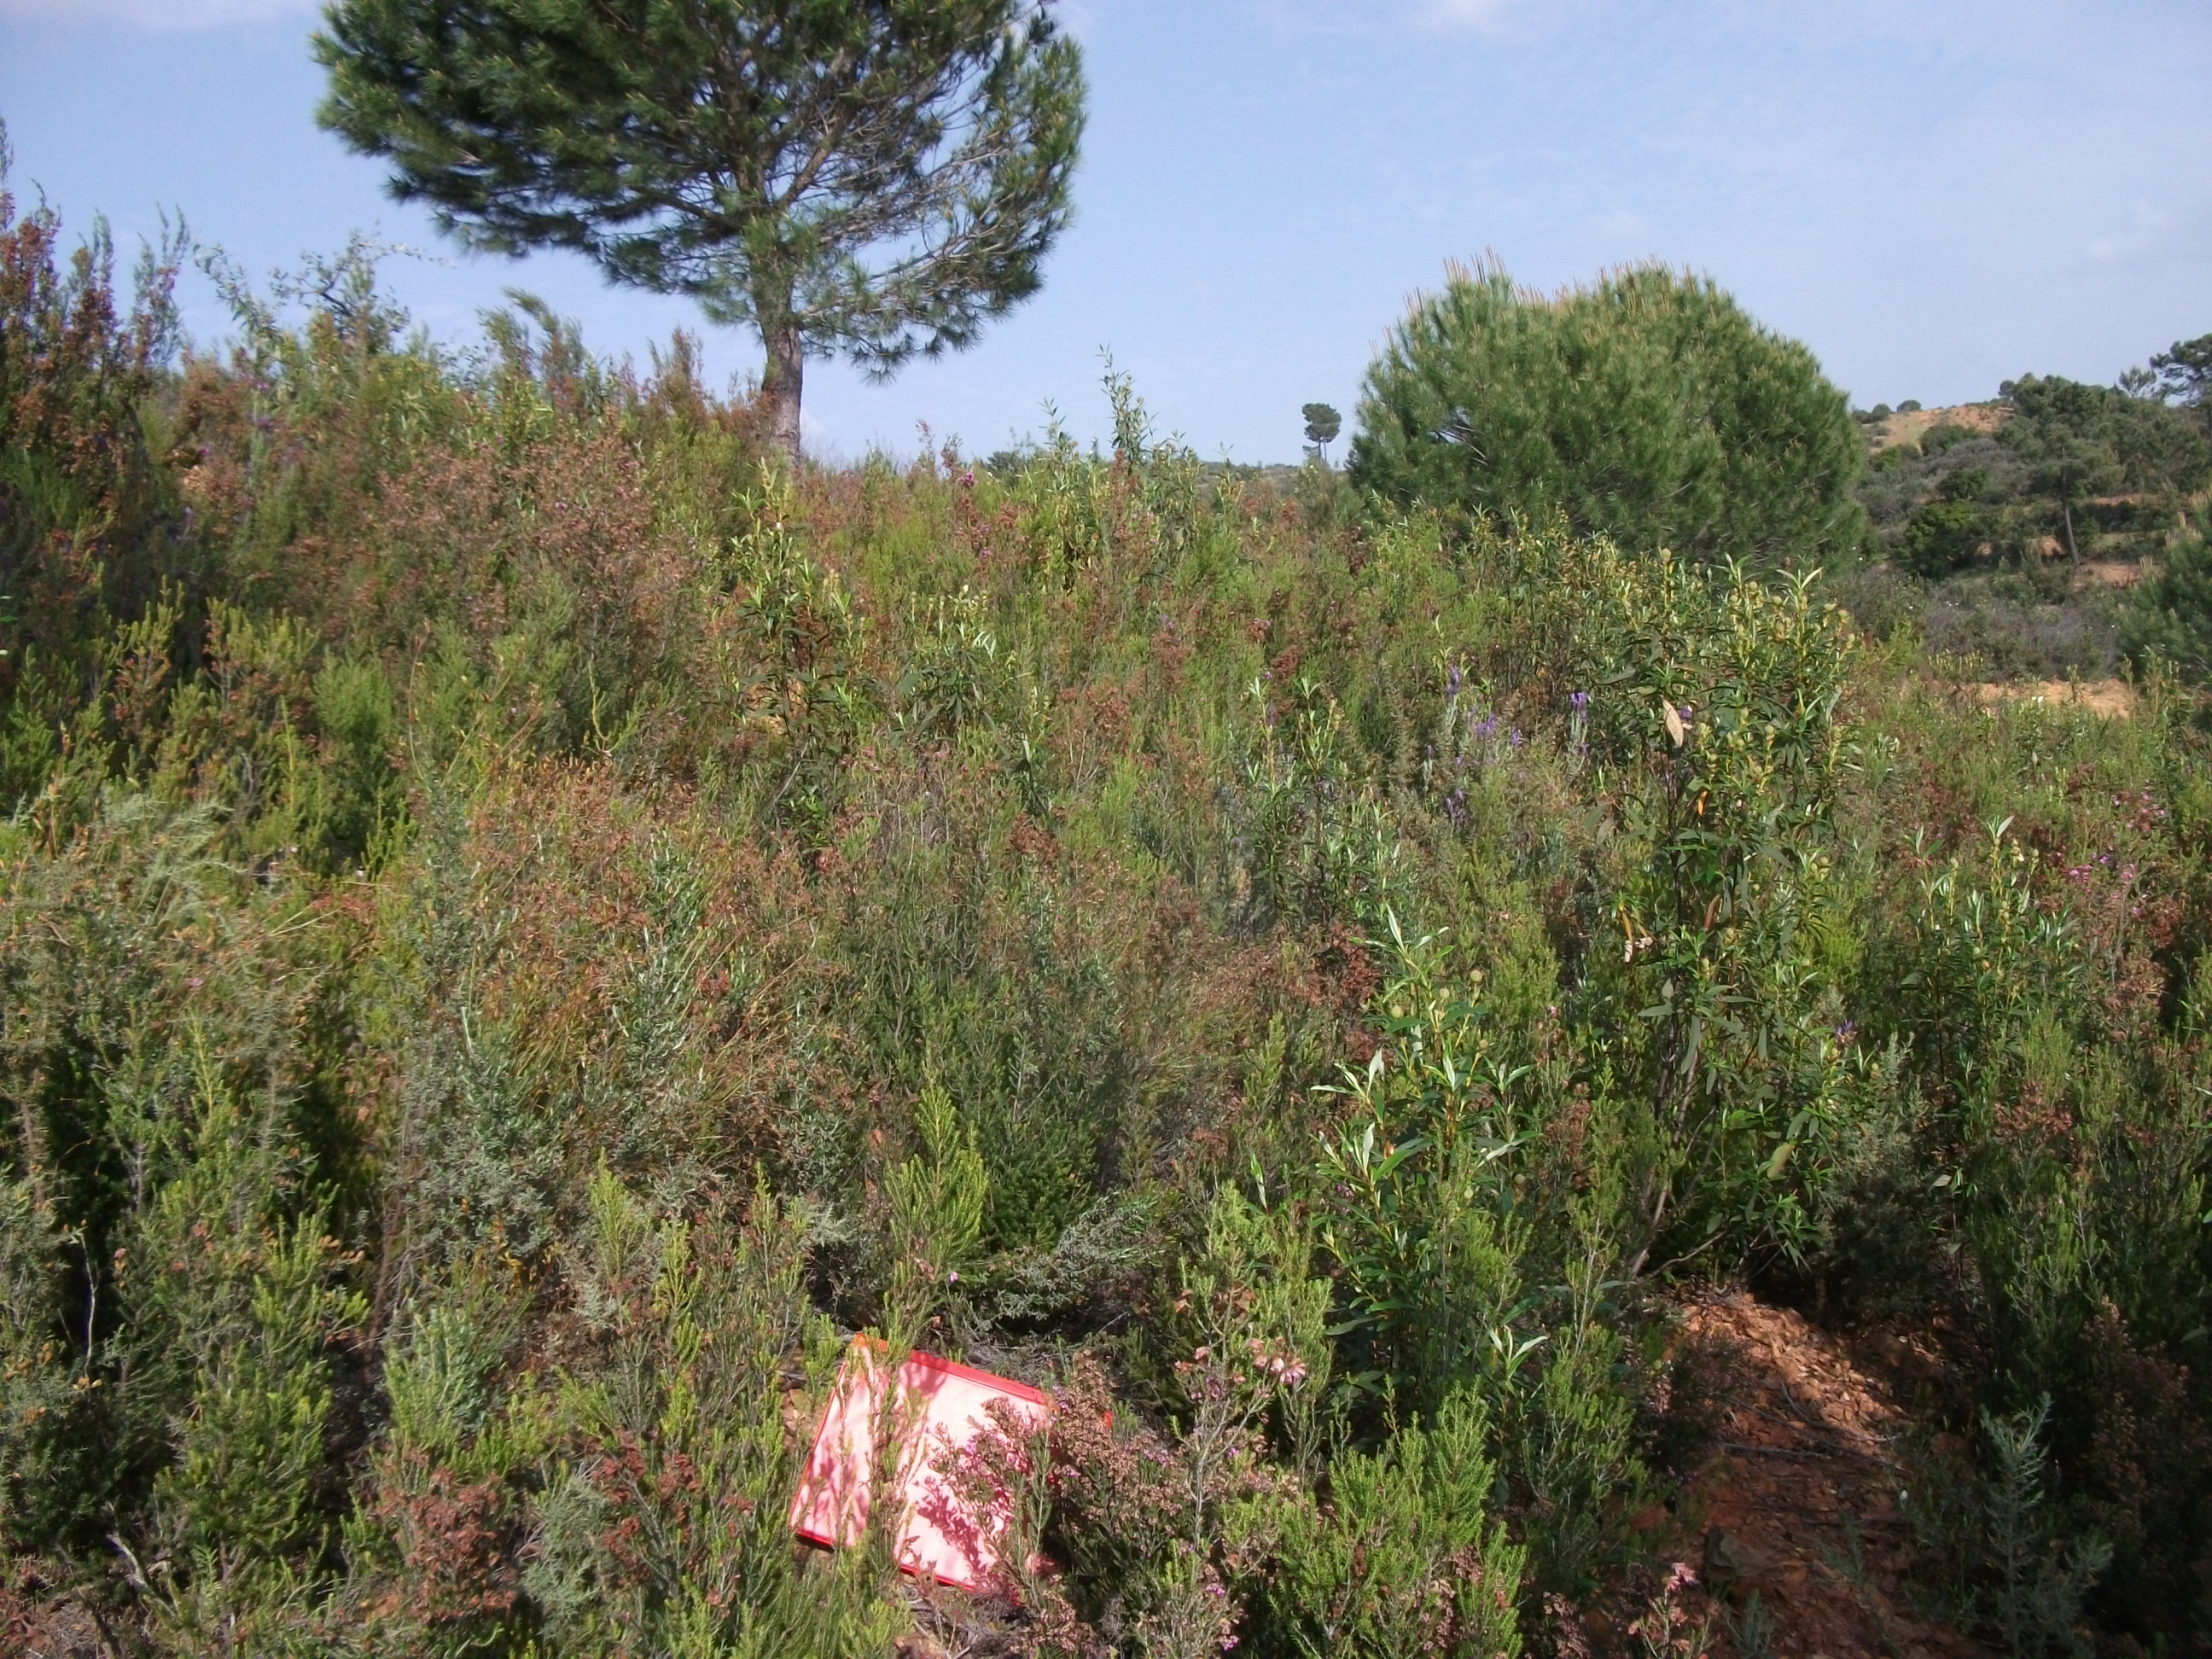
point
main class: Woodland
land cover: Pine dominated coniferous woodland
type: coniferous forest of the mediterranean region
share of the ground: 50 - 75 %
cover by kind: coniferous forest trees 70 %, shrubs 30 %
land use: Forestry
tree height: > 5 m
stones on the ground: 10 - 25 %
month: April
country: ES
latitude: 37.7952
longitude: -6.6809
